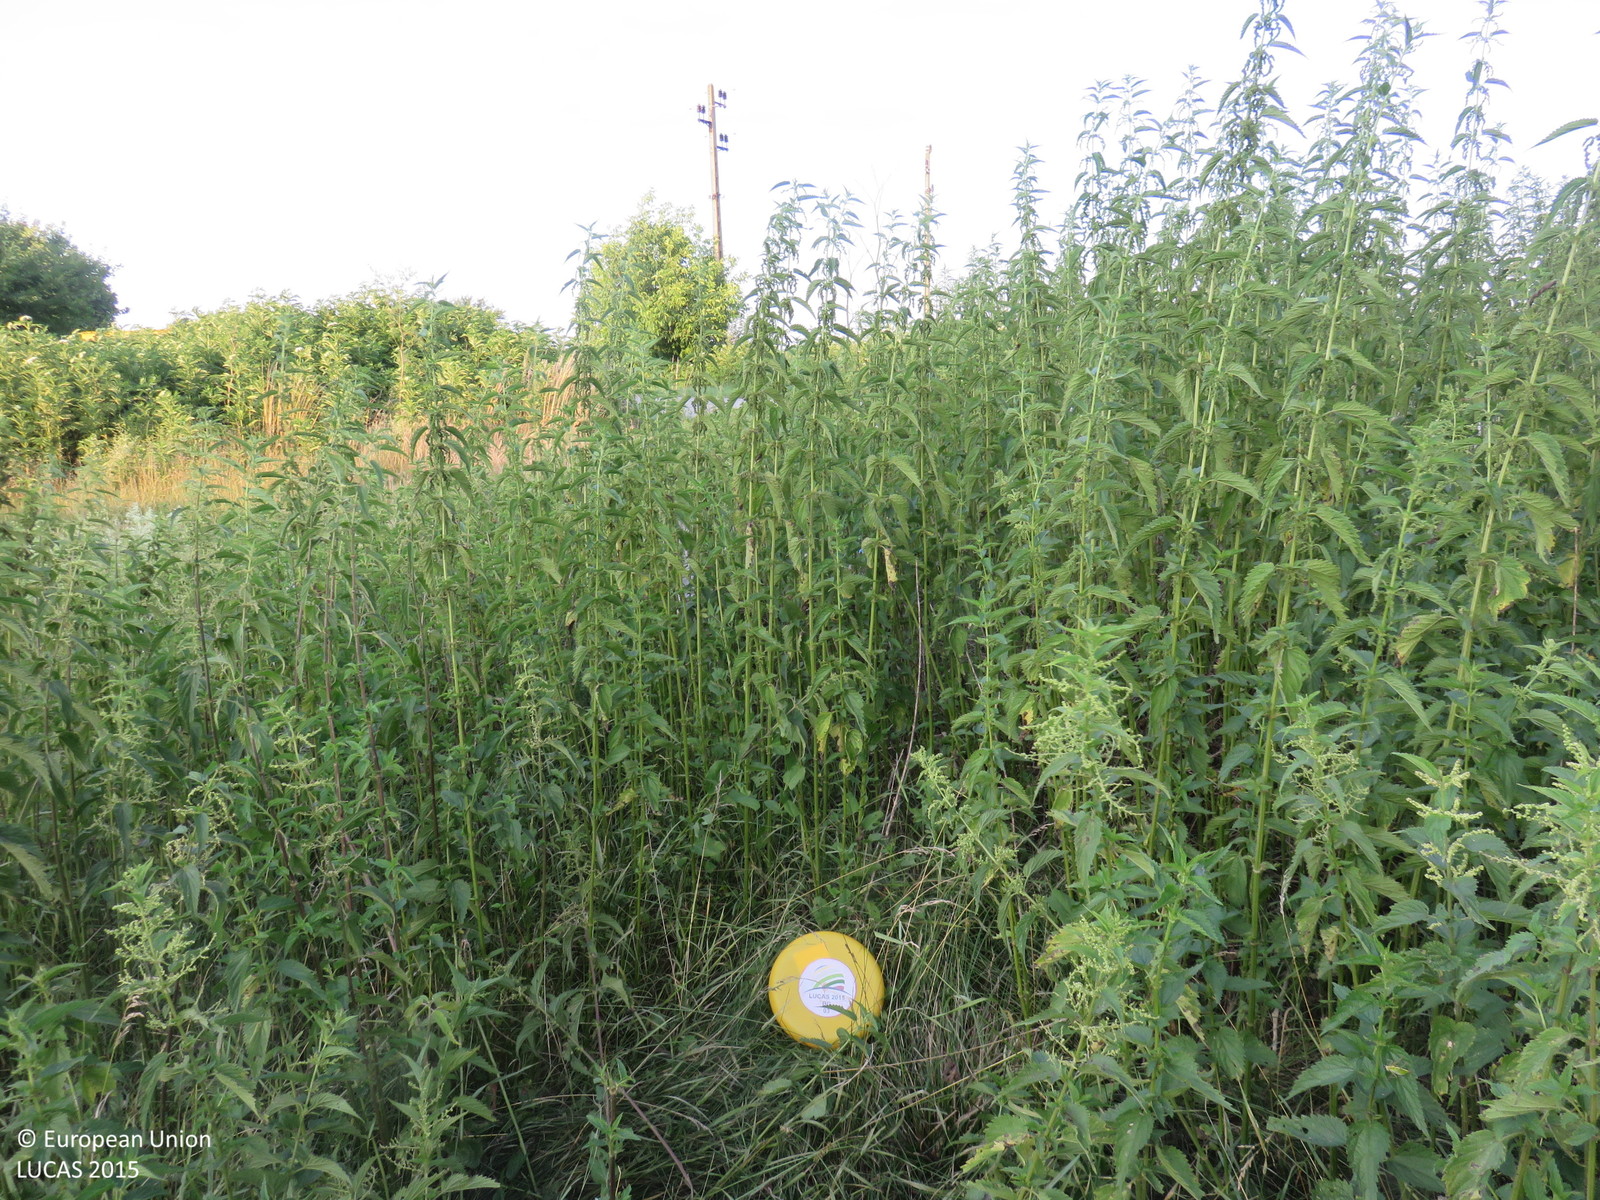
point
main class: Grassland
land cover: Grassland with sparse tree/shrub cover
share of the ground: > 75 %
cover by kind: herbaceous plants 95 %, broadleaved forest trees 5 %
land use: Agriculture (excluding fallow land and kitchen gardens)
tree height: > 5 m
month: June
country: BG
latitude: 43.3148
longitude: 25.0762
